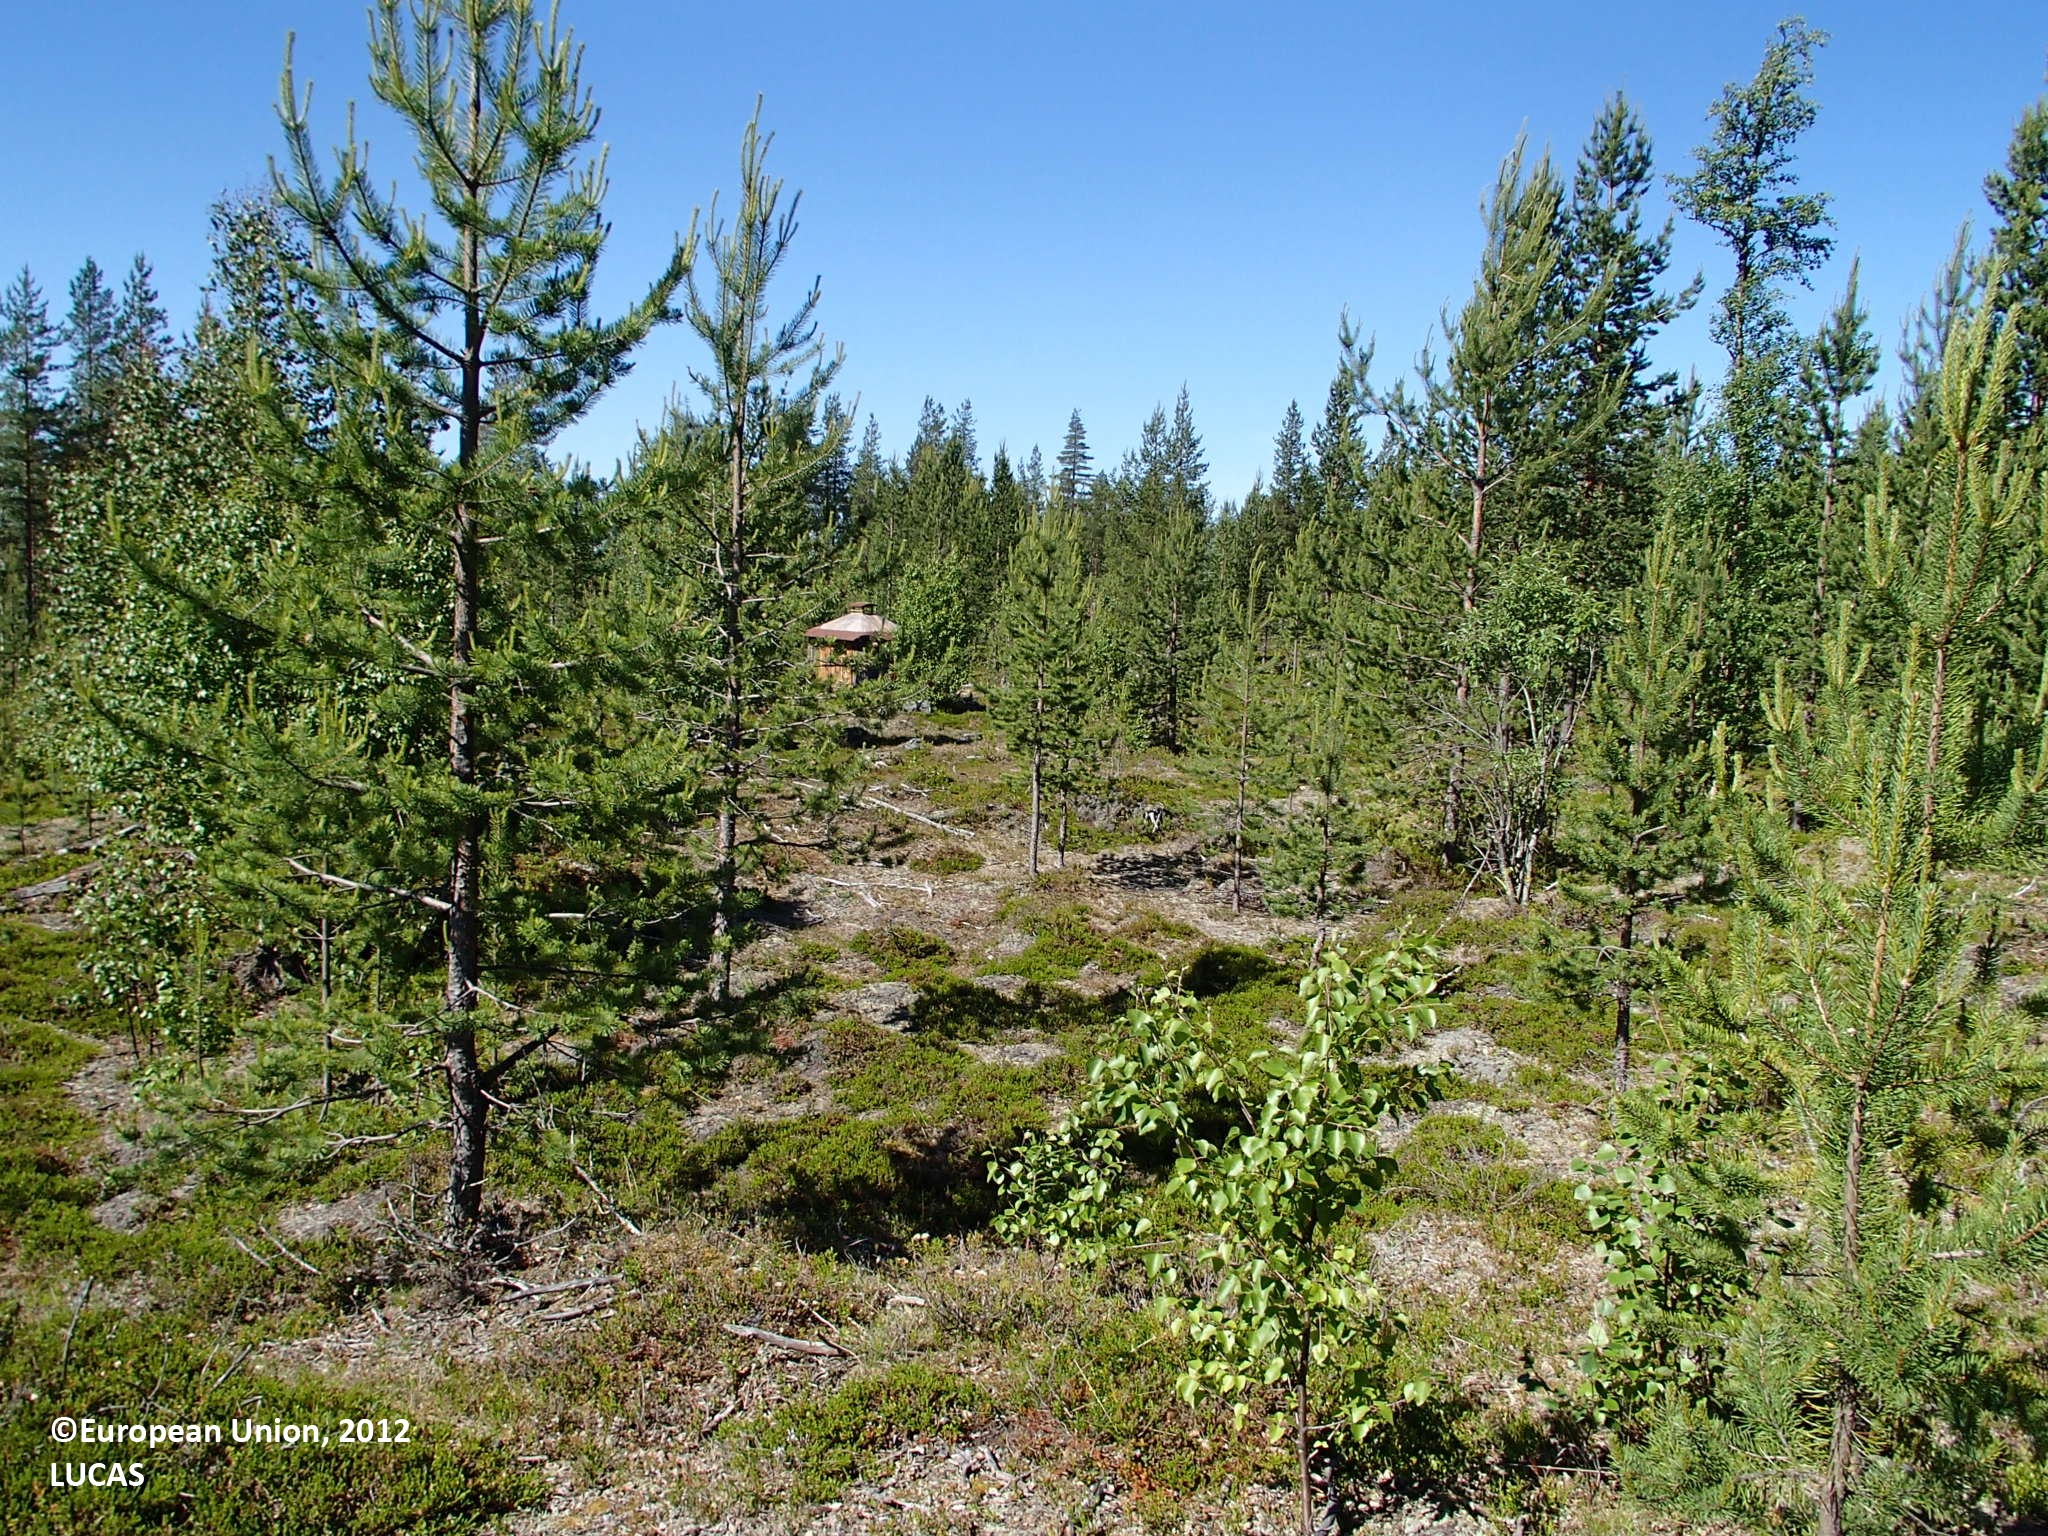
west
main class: Woodland
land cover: Other mixed woodland
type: boreal forest
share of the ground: 10 - 25 %
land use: Forestry
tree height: > 5 m
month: July
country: FI
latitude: 67.1153
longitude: 26.6497
